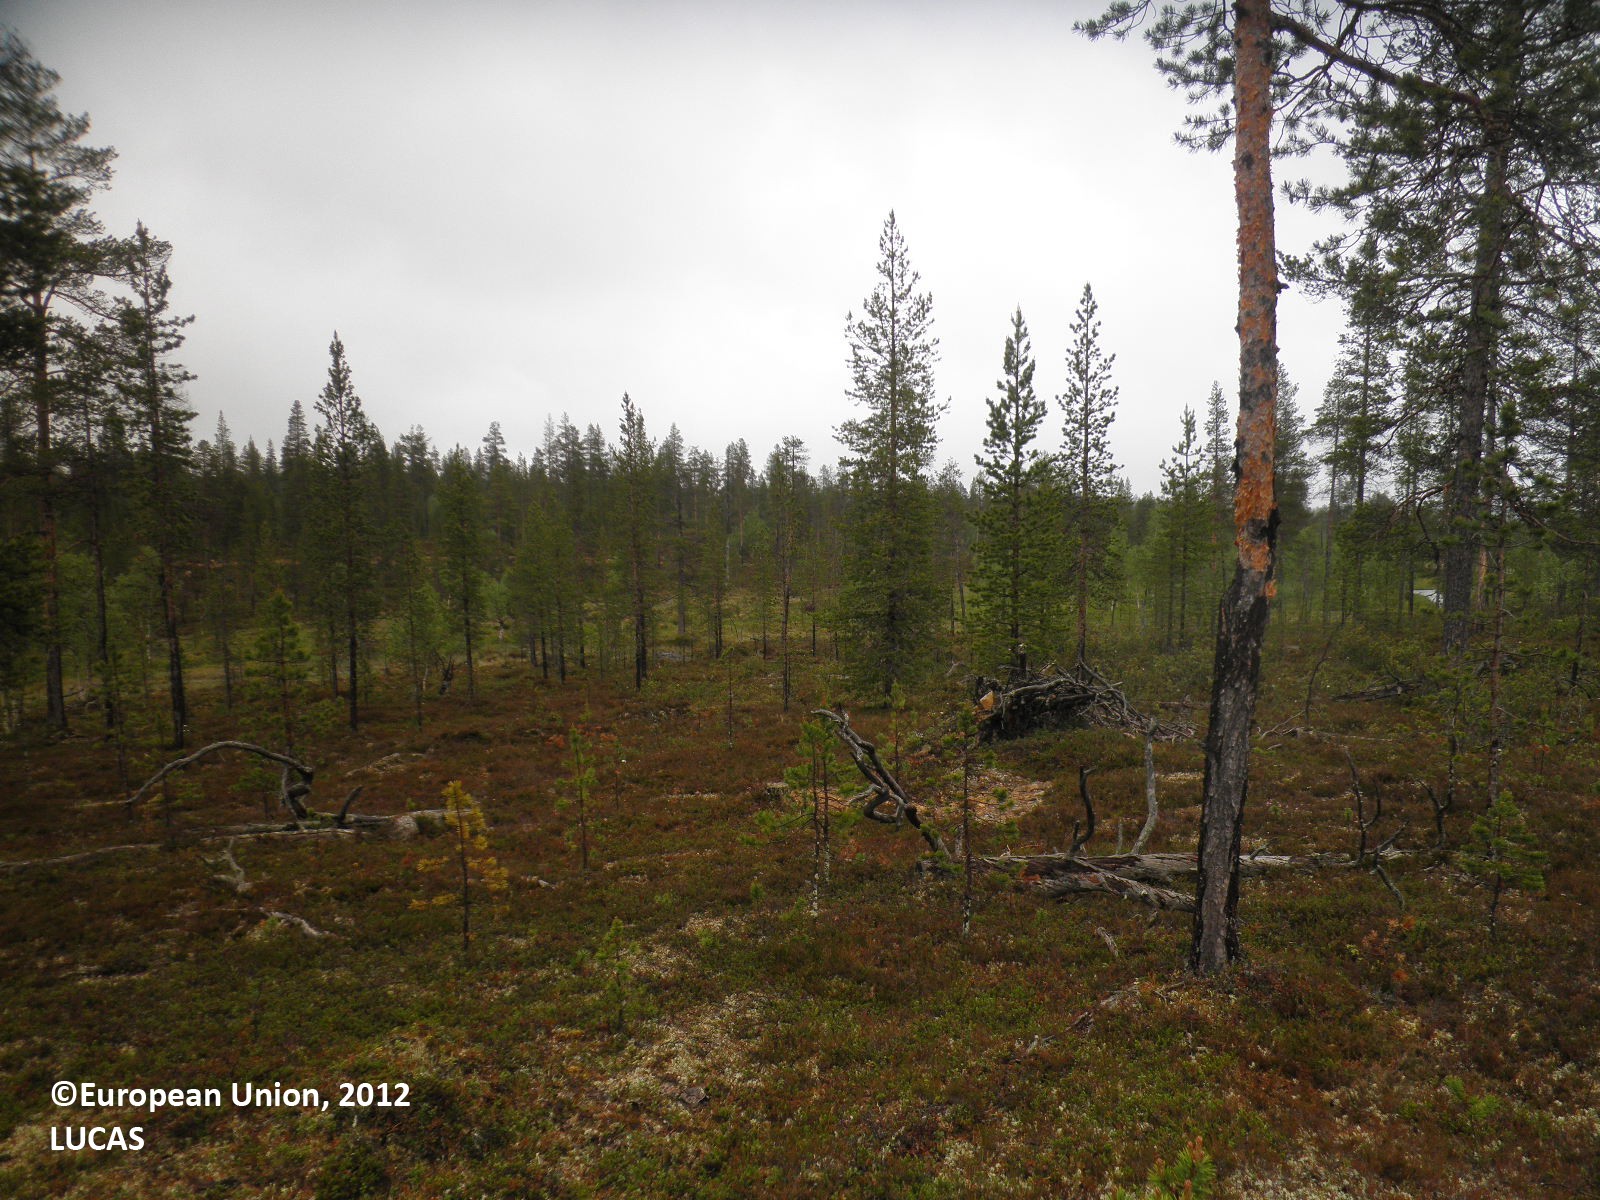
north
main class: Woodland
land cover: Pine dominated coniferous woodland
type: boreal forest
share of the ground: 25 - 50 %
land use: Forestry
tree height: > 5 m
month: June
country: FI
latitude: 68.4806
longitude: 27.5982
